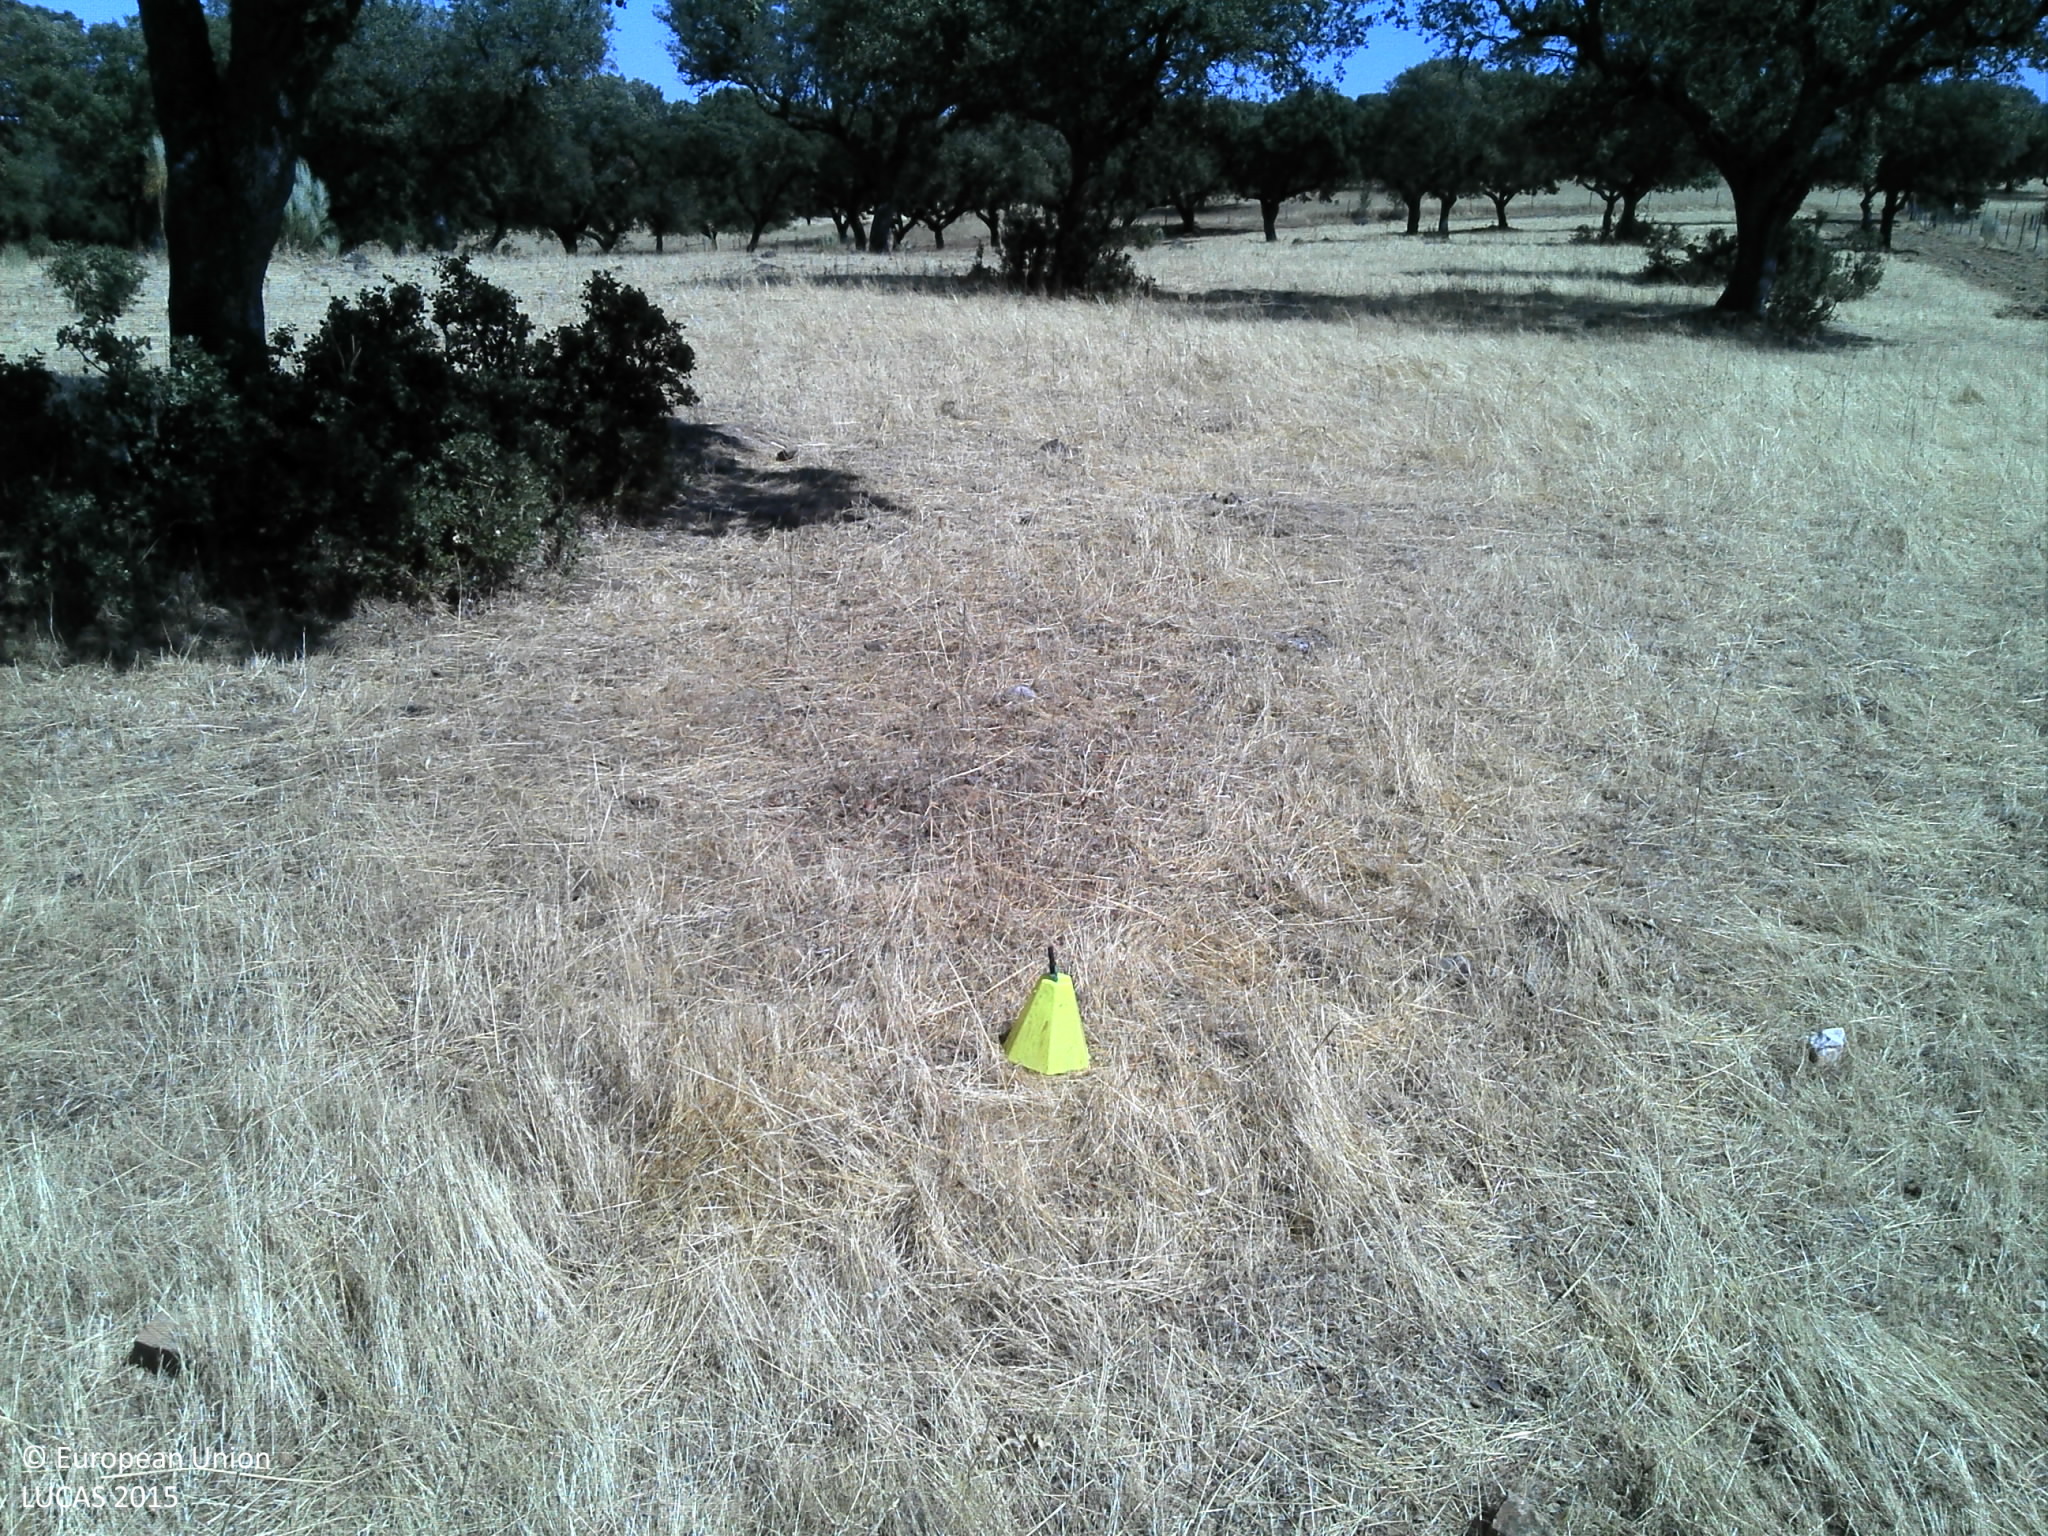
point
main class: Woodland
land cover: Broadleaved woodland
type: broadleaved evergreen forest
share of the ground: 25 - 50 %
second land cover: Grassland without tree/shrub cover
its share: 10 - 25 %
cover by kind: unconsolidated bare surface 55 %, broadleaved forest trees 25 %, herbaceous plants 20 %
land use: Forestry
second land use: Agriculture (excluding fallow land and kitchen gardens)
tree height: > 5 m
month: July
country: PT
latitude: 39.0243
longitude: -7.5384
